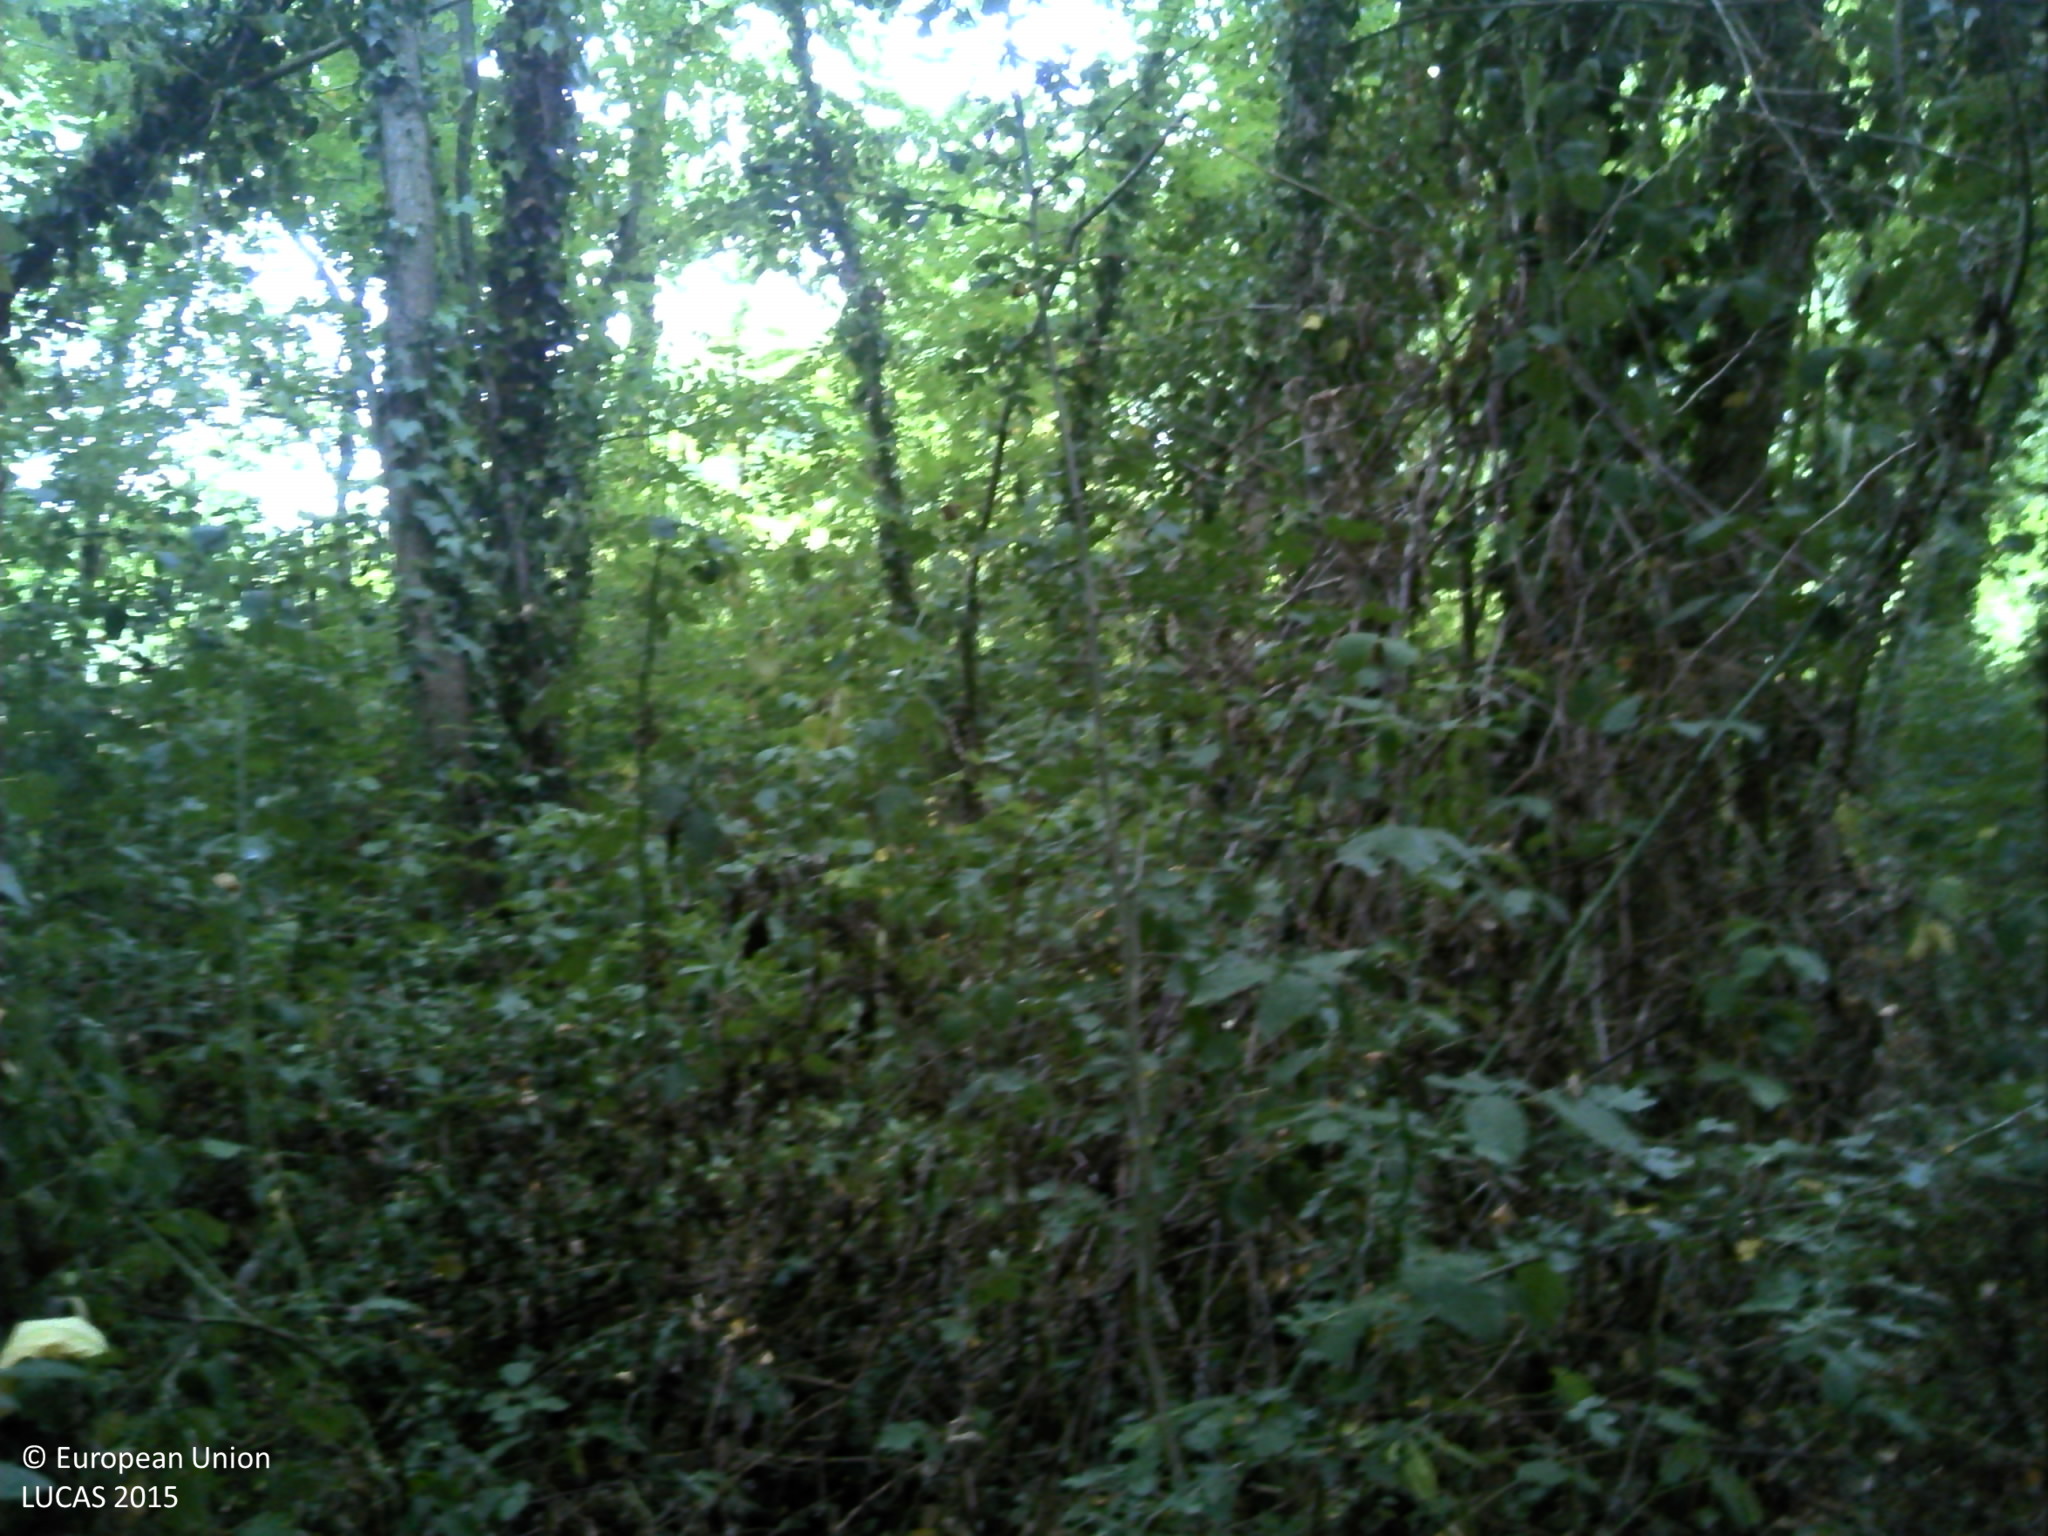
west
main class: Woodland
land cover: Broadleaved woodland
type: acidophilous oak and oak-birch forest
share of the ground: > 75 %
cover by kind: broadleaved forest trees 60 %, shrubs 30 %, herbaceous plants 5 %, lichens and mosses 5 %
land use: Semi-natural and natural areas not in use
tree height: > 5 m
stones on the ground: 10 - 25 %
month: July
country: FR
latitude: 44.6553
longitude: -0.4706
